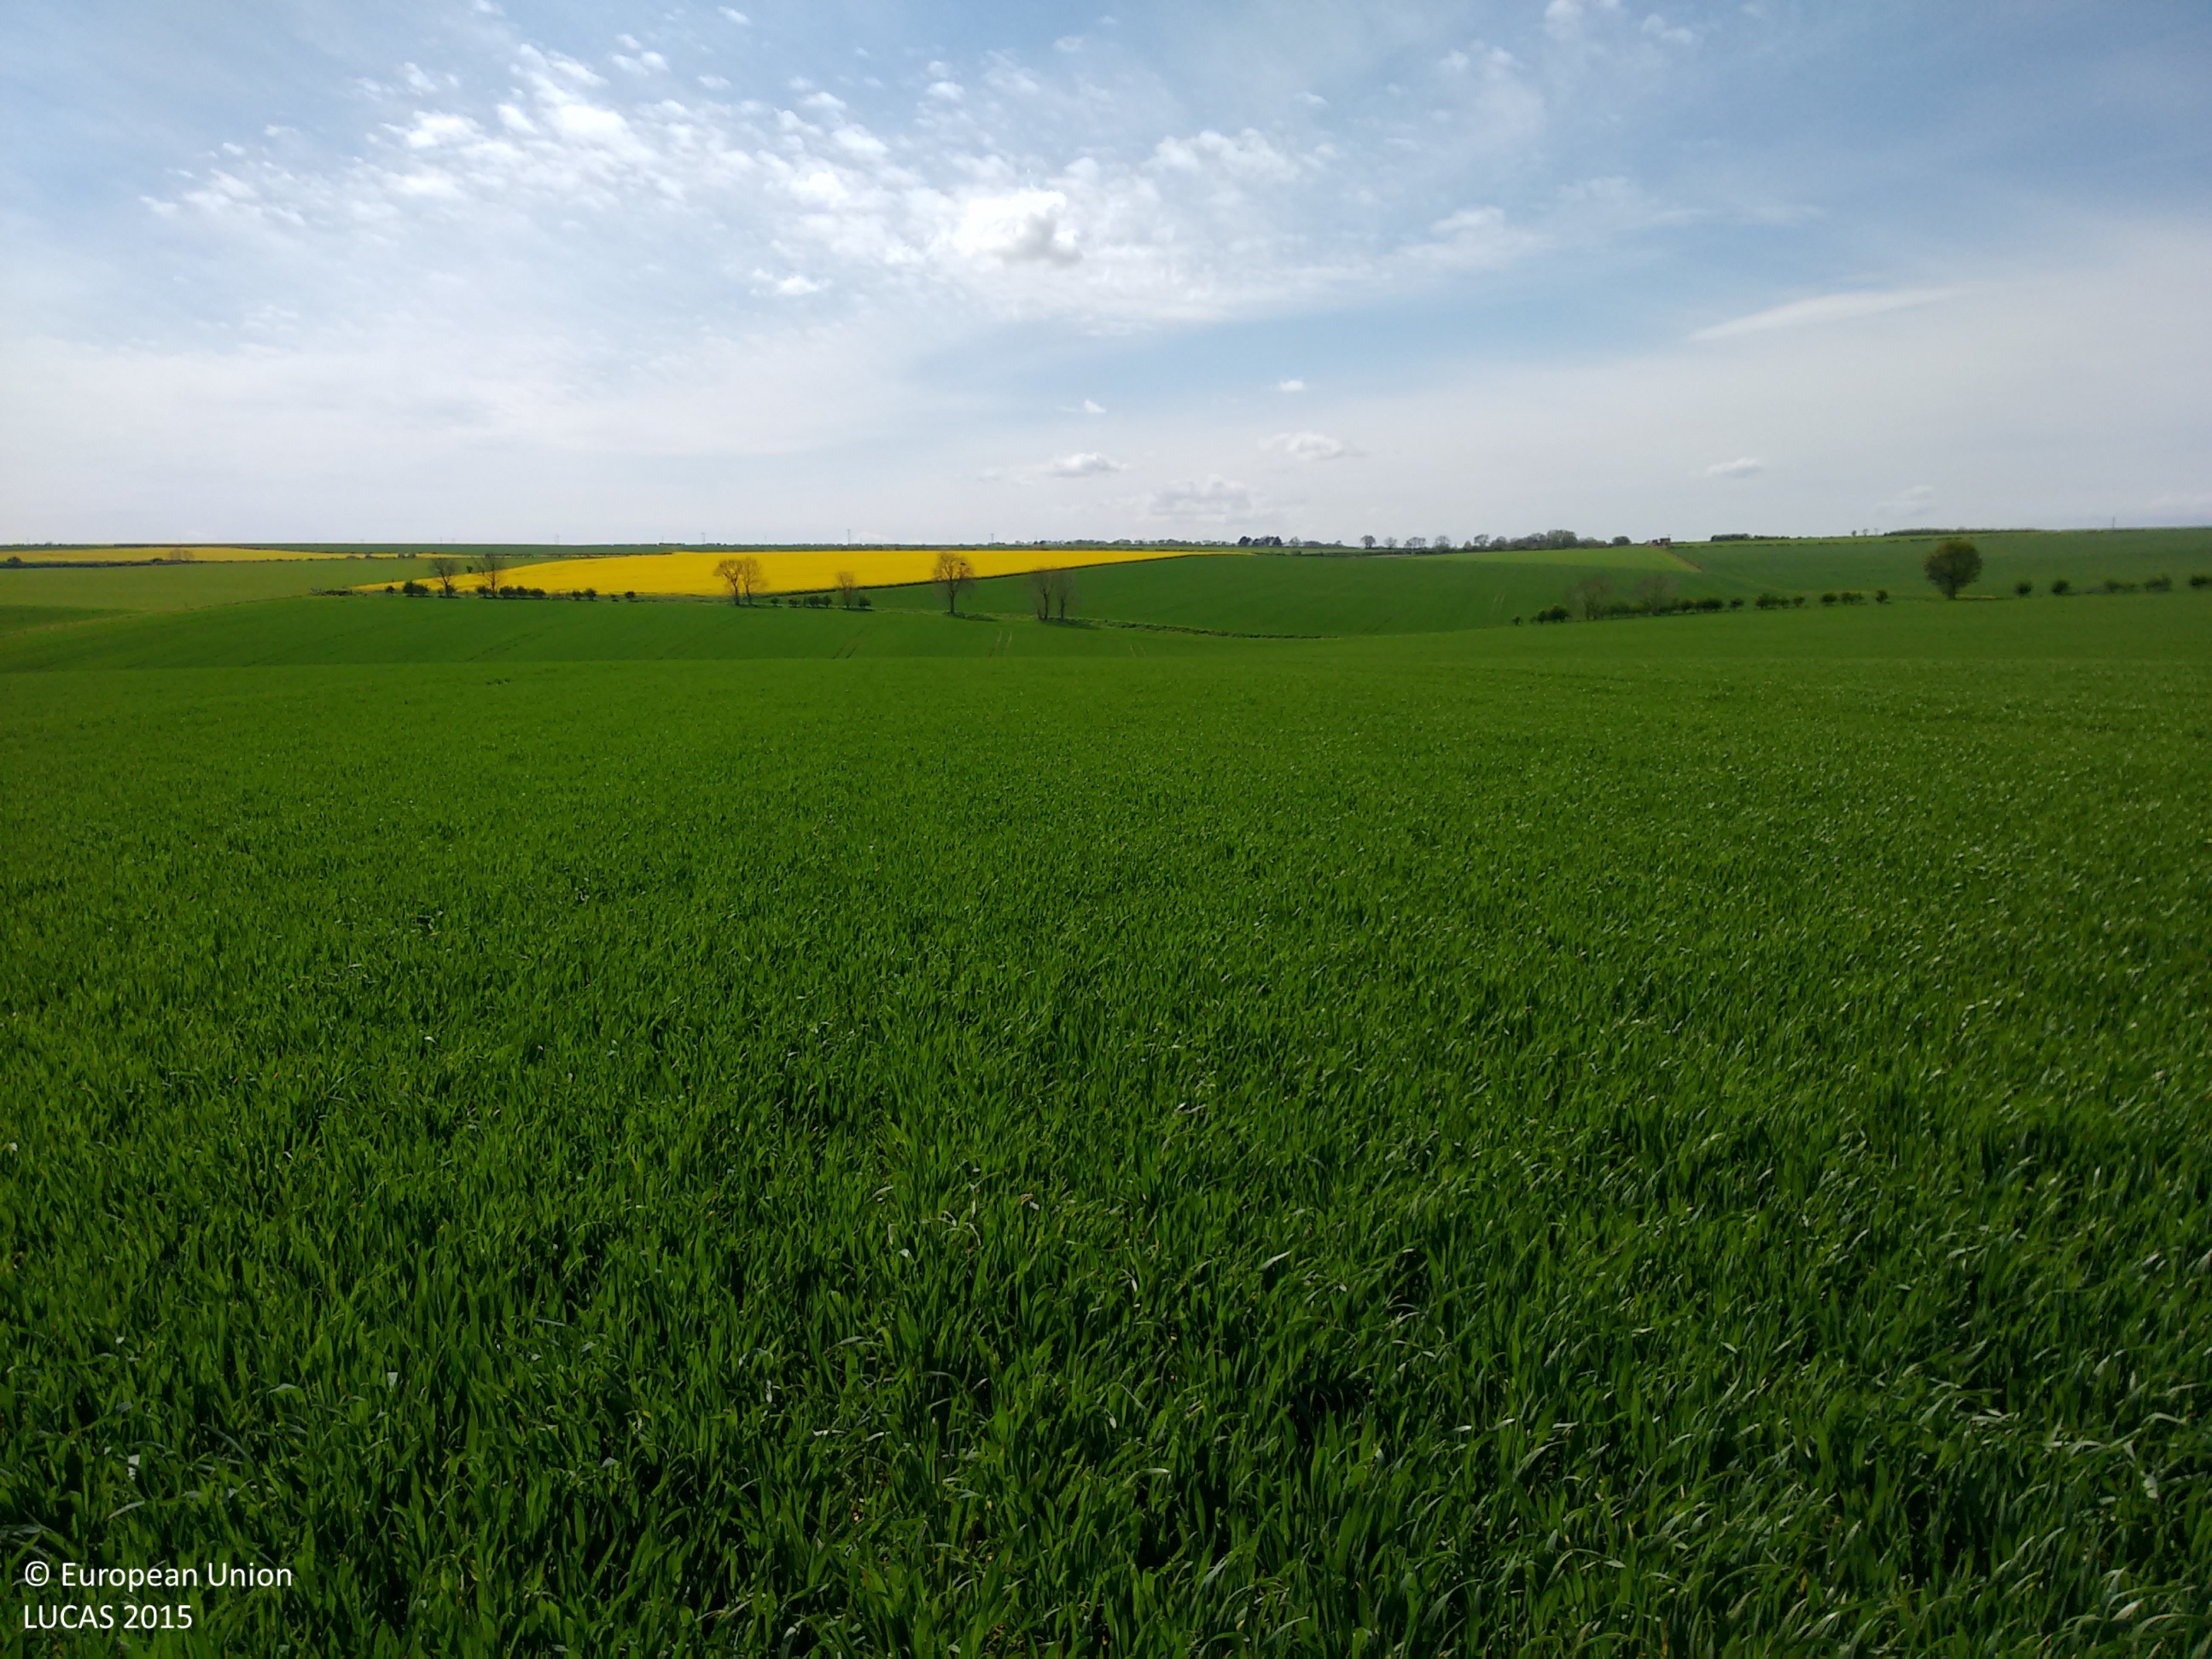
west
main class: Cropland
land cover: Common wheat
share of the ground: > 75 %
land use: Agriculture (excluding fallow land and kitchen gardens)
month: May
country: GB
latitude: 54.1167
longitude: -0.3613
